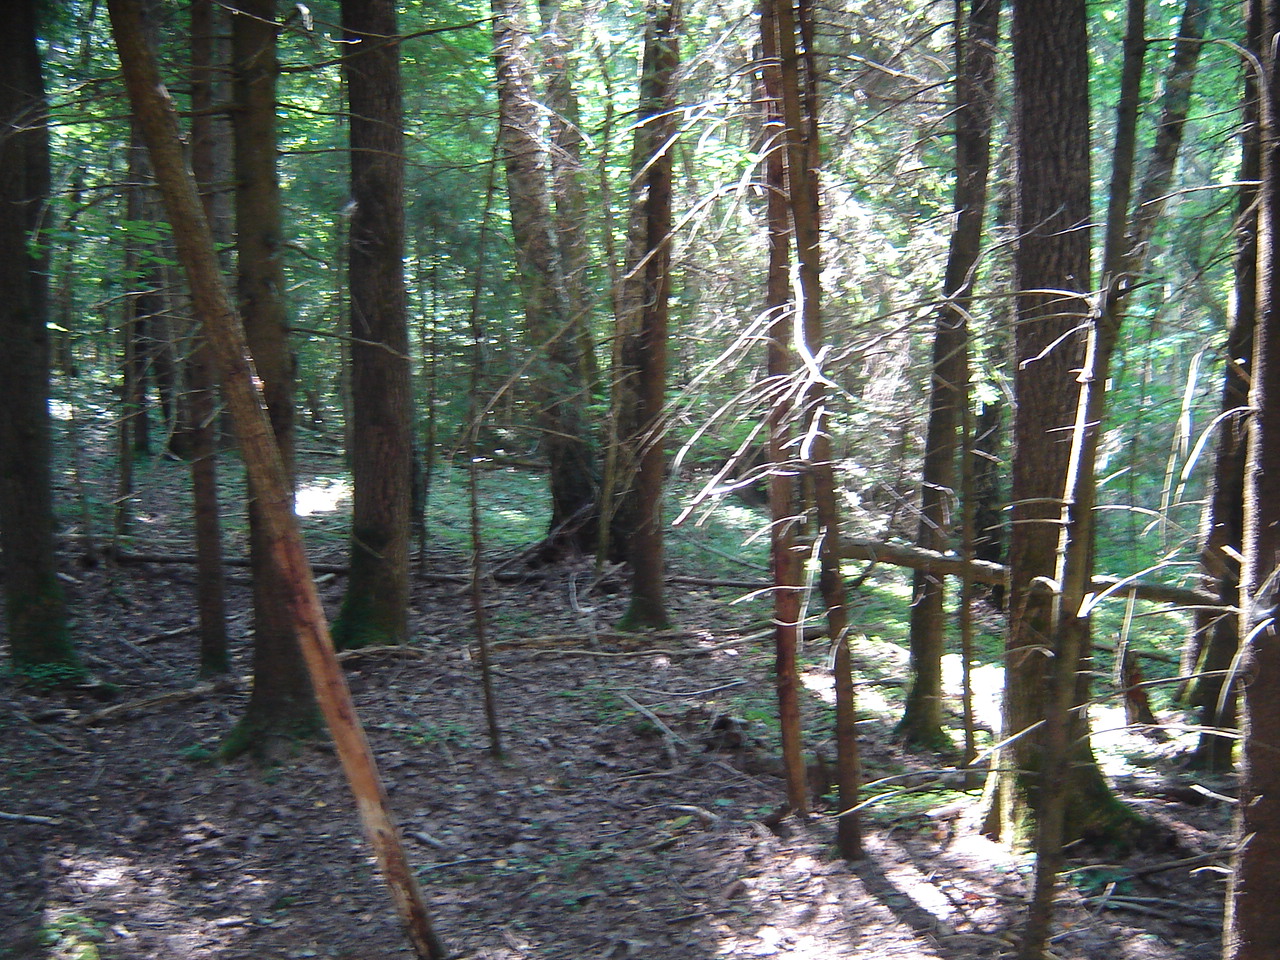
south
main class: Woodland
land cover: Spruce dominated mixed woodland
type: hemiboreal forest and nemoral coniferous forest and mixed broadleaved-coniferous forest
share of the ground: > 75 %
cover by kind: coniferous forest trees 60 %, broadleaved forest trees 30 %, herbaceous plants 5 %, unconsolidated bare surface 5 %
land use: Forestry
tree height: > 5 m
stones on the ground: < 10 %
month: August
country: LT
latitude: 55.1866
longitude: 25.0184
